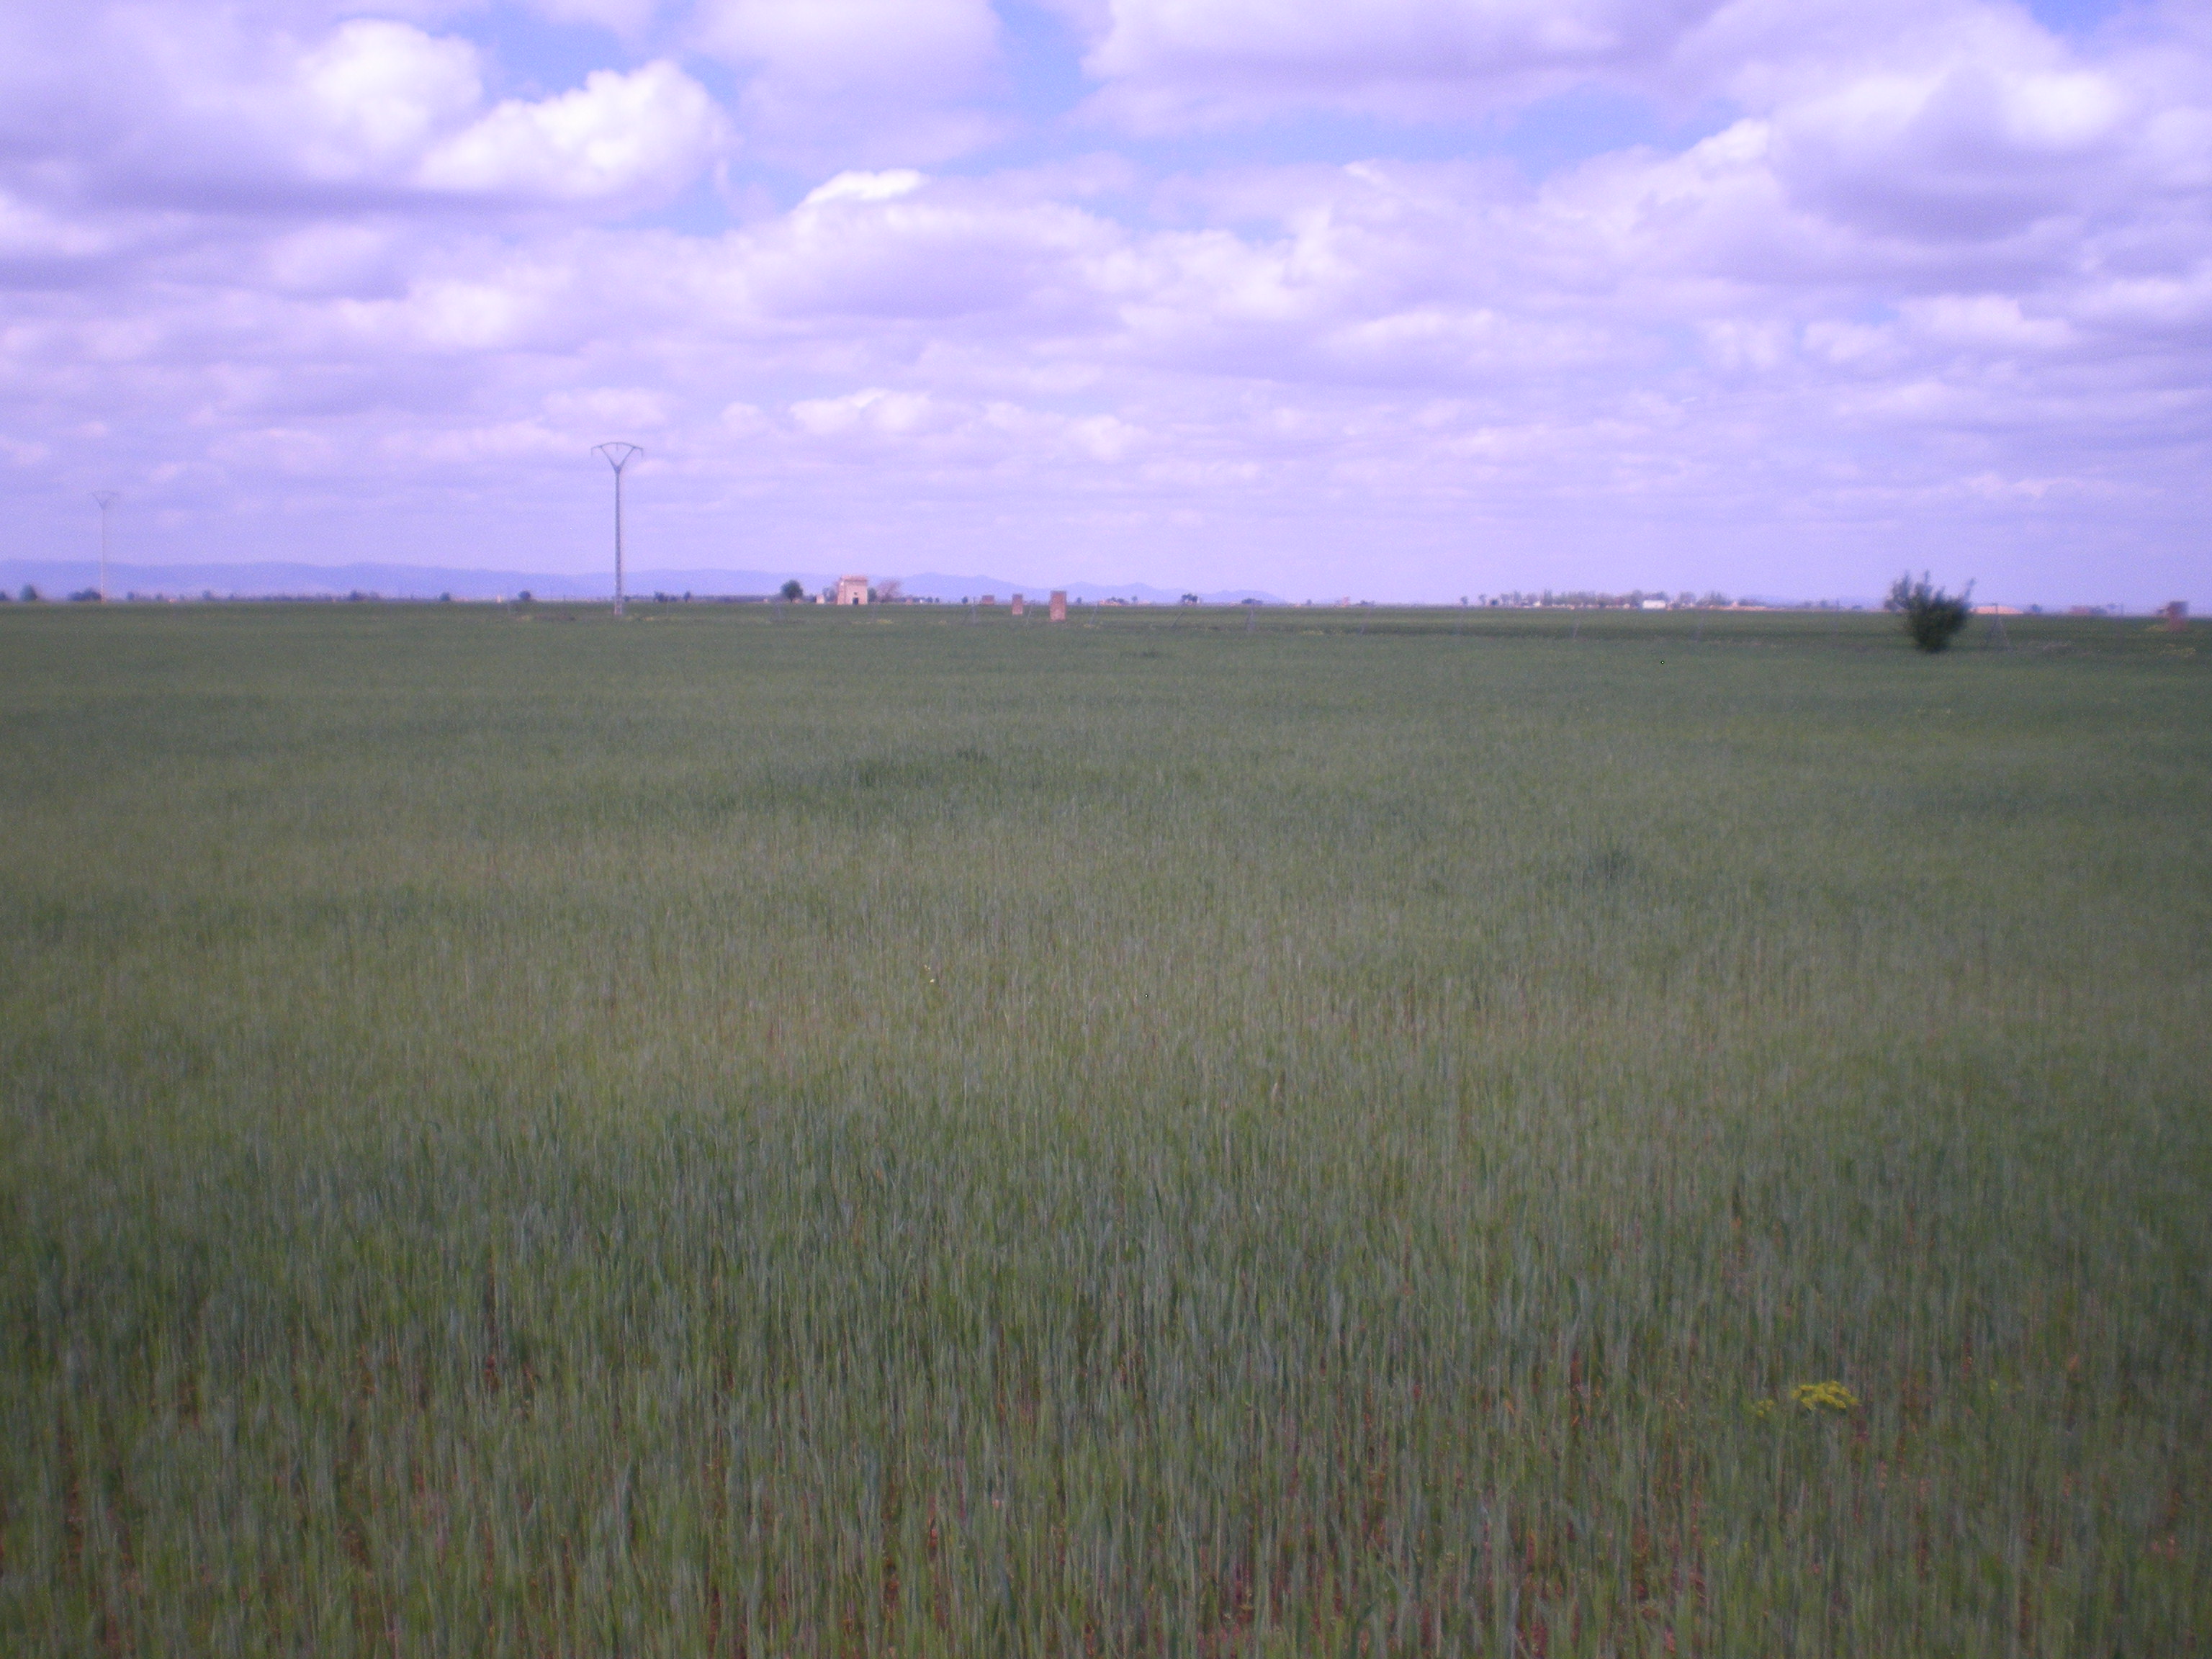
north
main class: Cropland
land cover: Durum wheat
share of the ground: 50 - 75 %
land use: Agriculture (excluding fallow land and kitchen gardens)
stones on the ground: 10 - 25 %
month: April
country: ES
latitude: 38.9622
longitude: -3.5061
